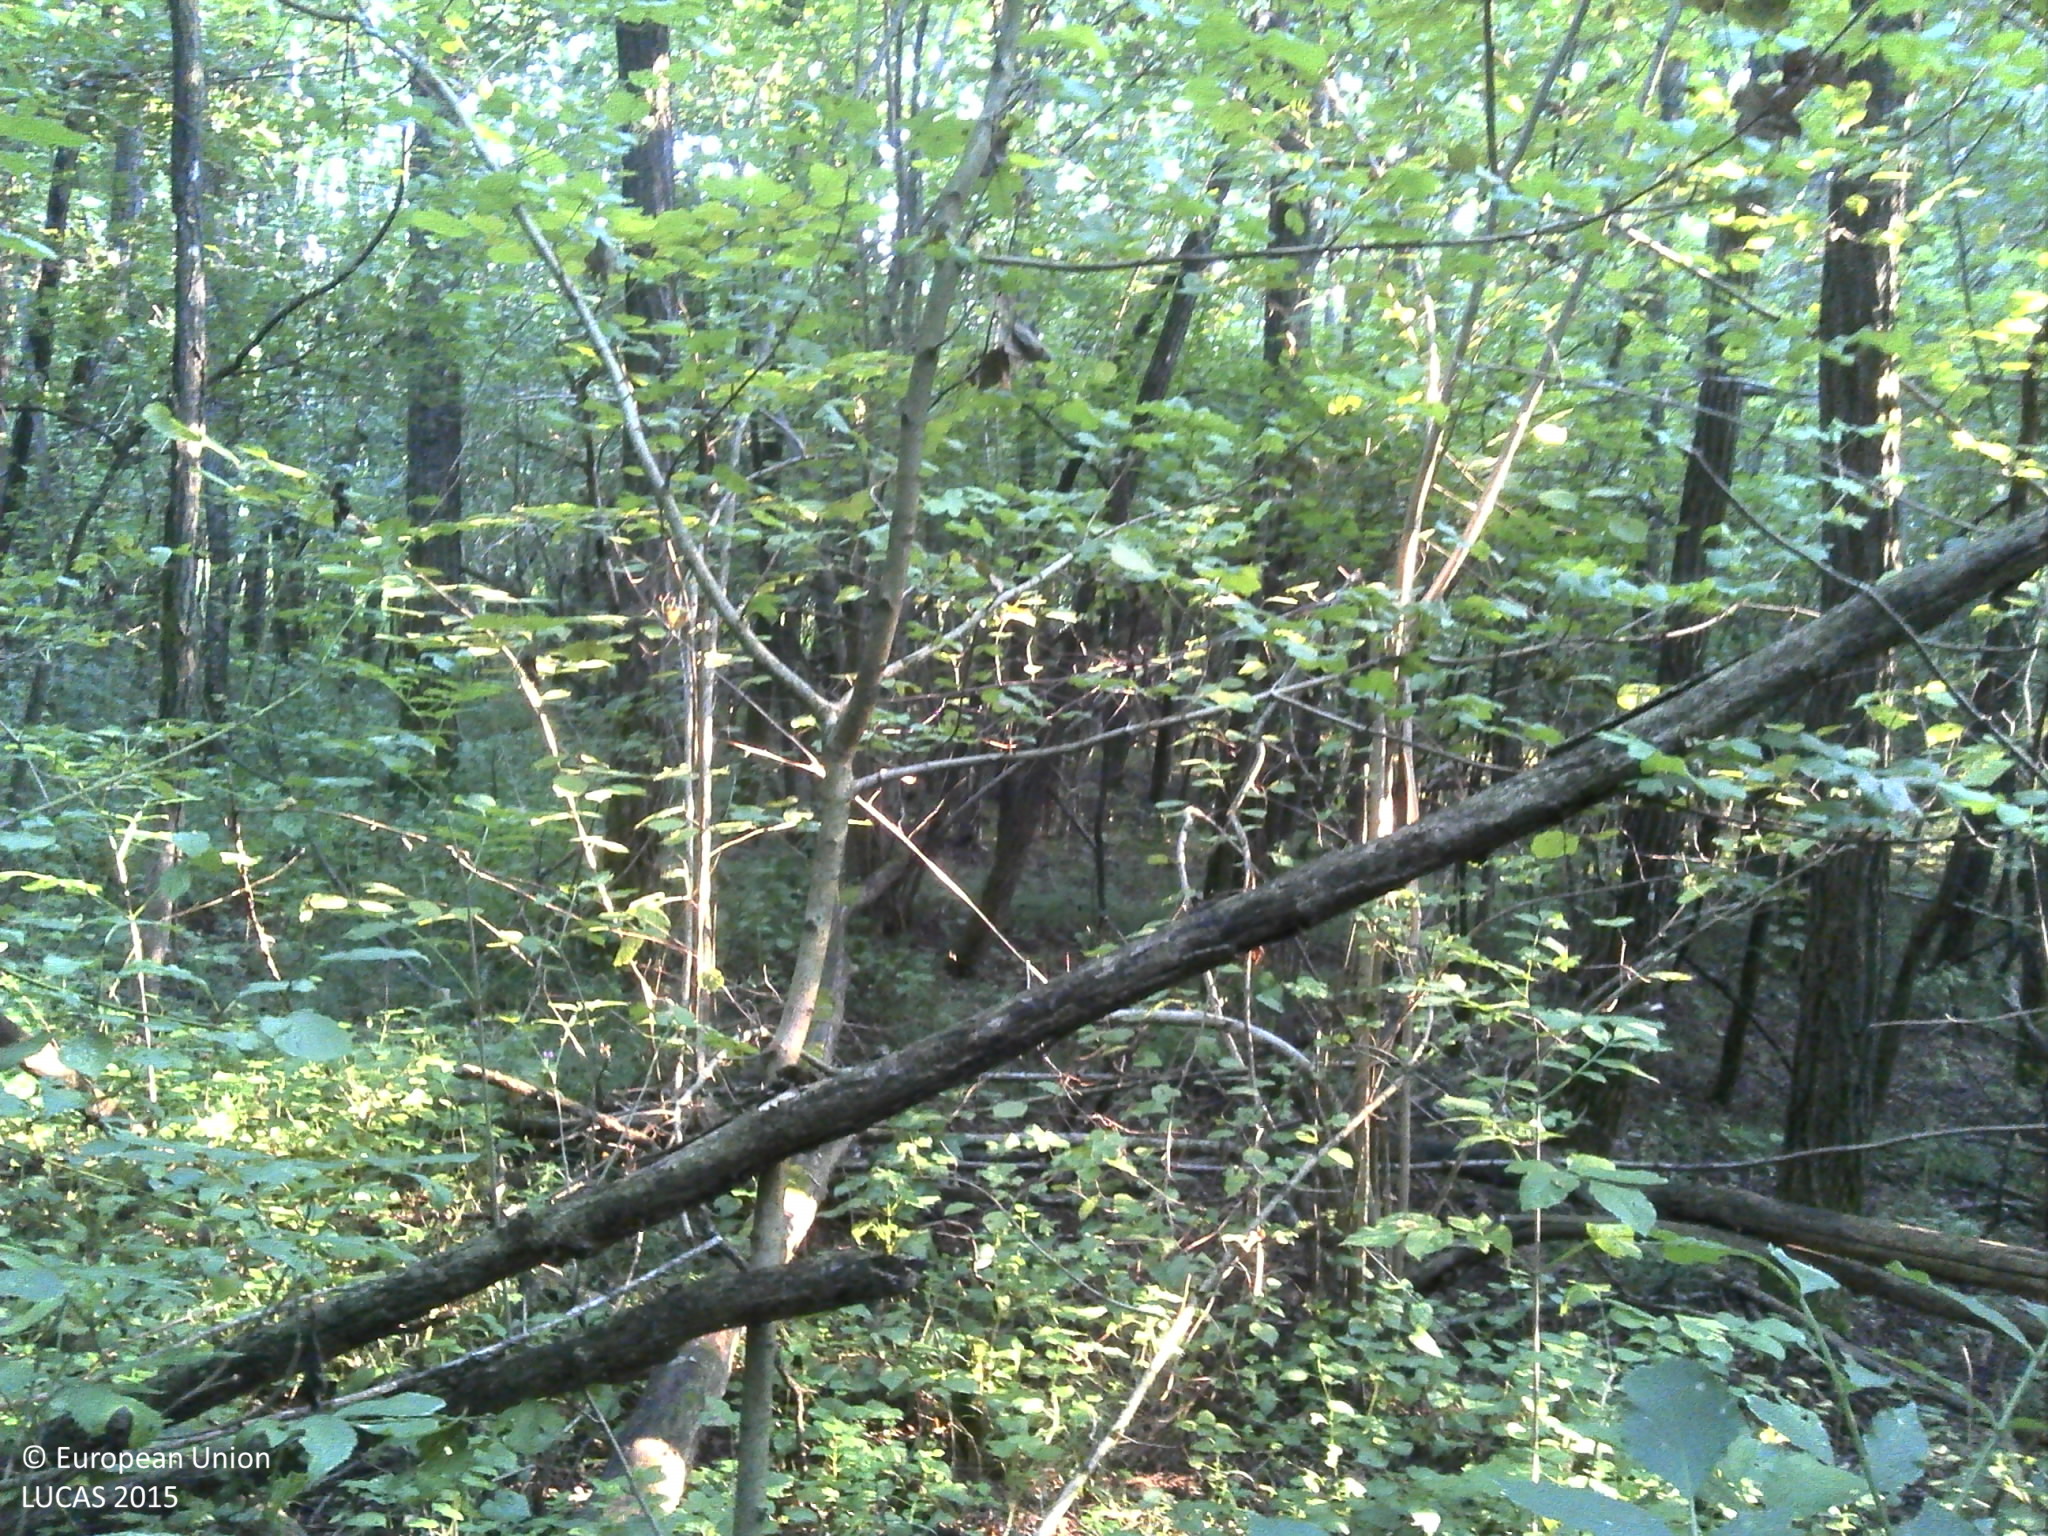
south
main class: Woodland
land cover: Broadleaved woodland
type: acidophilous oak and oak-birch forest
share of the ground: > 75 %
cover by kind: broadleaved forest trees 100 %
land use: Forestry
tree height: > 5 m
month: August
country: HR
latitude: 45.3575
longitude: 16.2138
